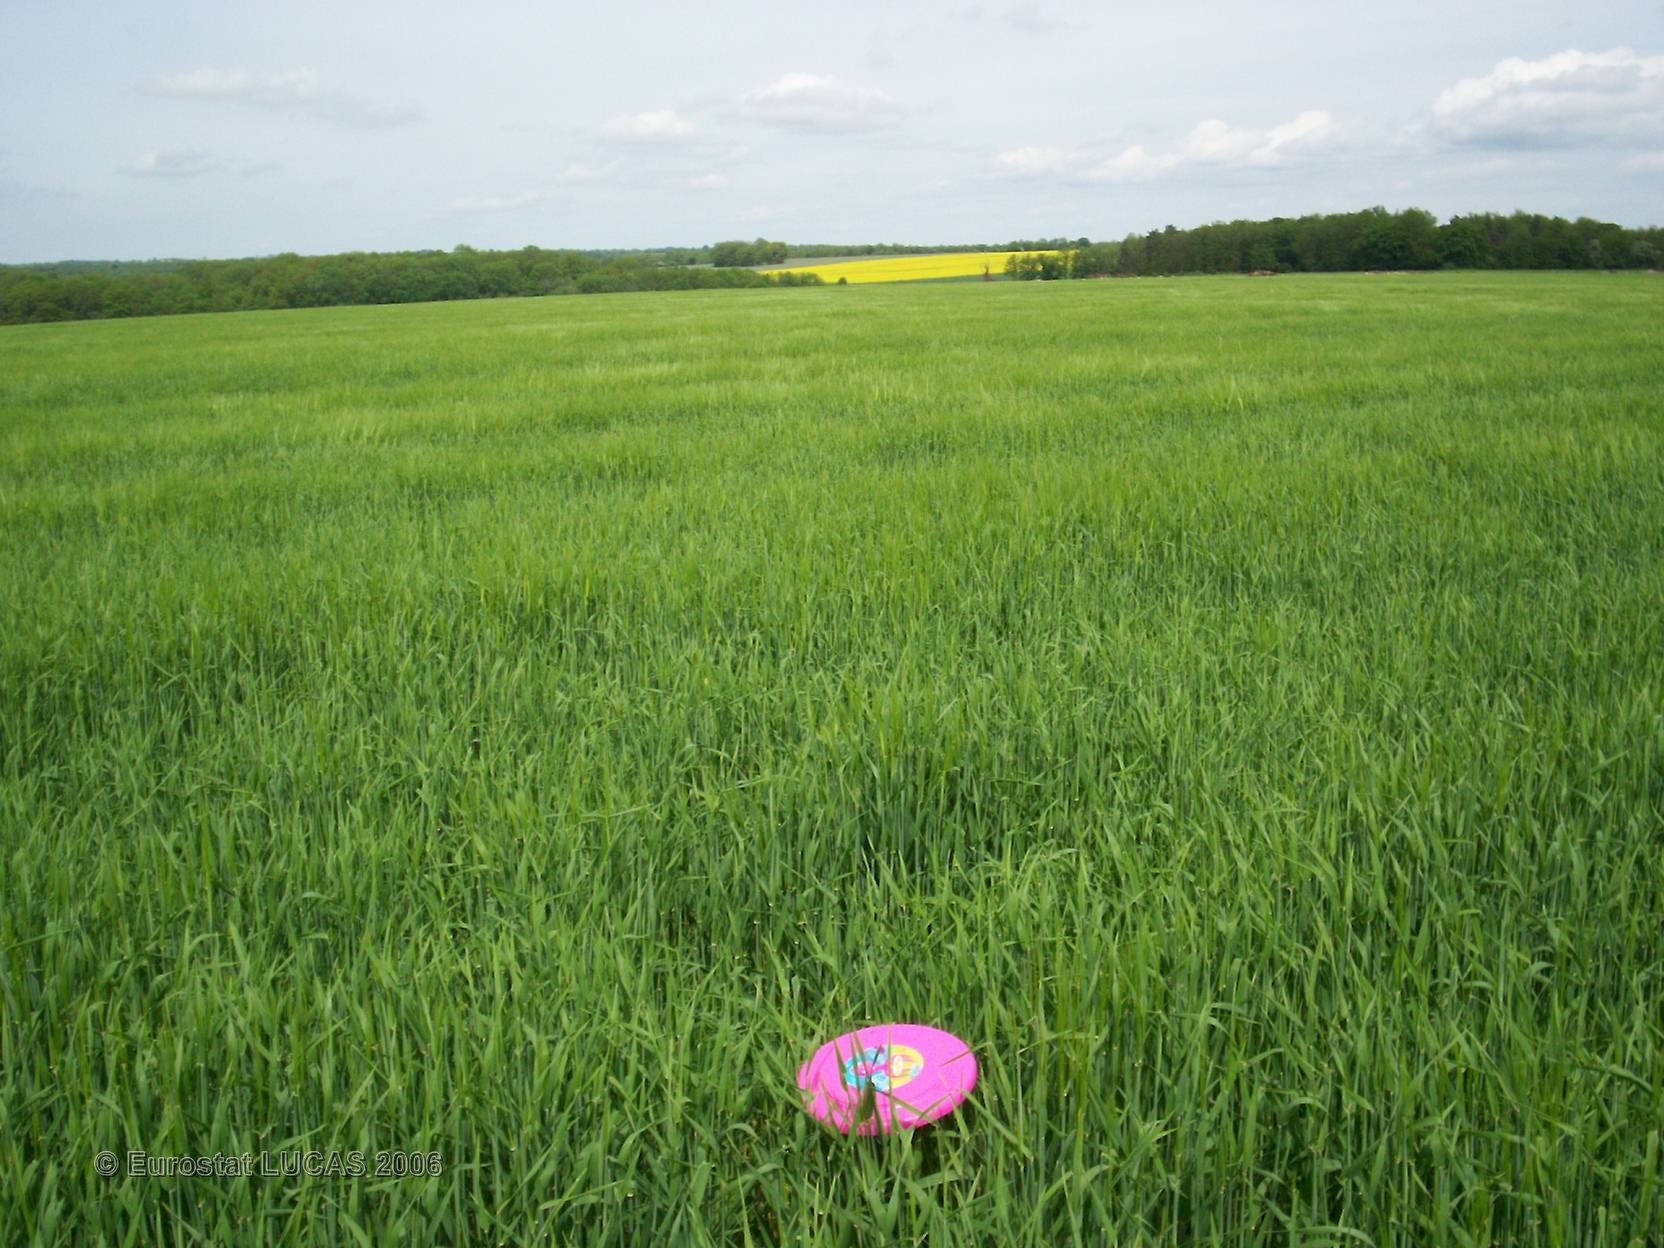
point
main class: Cropland
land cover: Barley
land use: Agriculture (excluding fallow land and kitchen gardens)
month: May
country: FR
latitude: 47.3317
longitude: 4.5608
